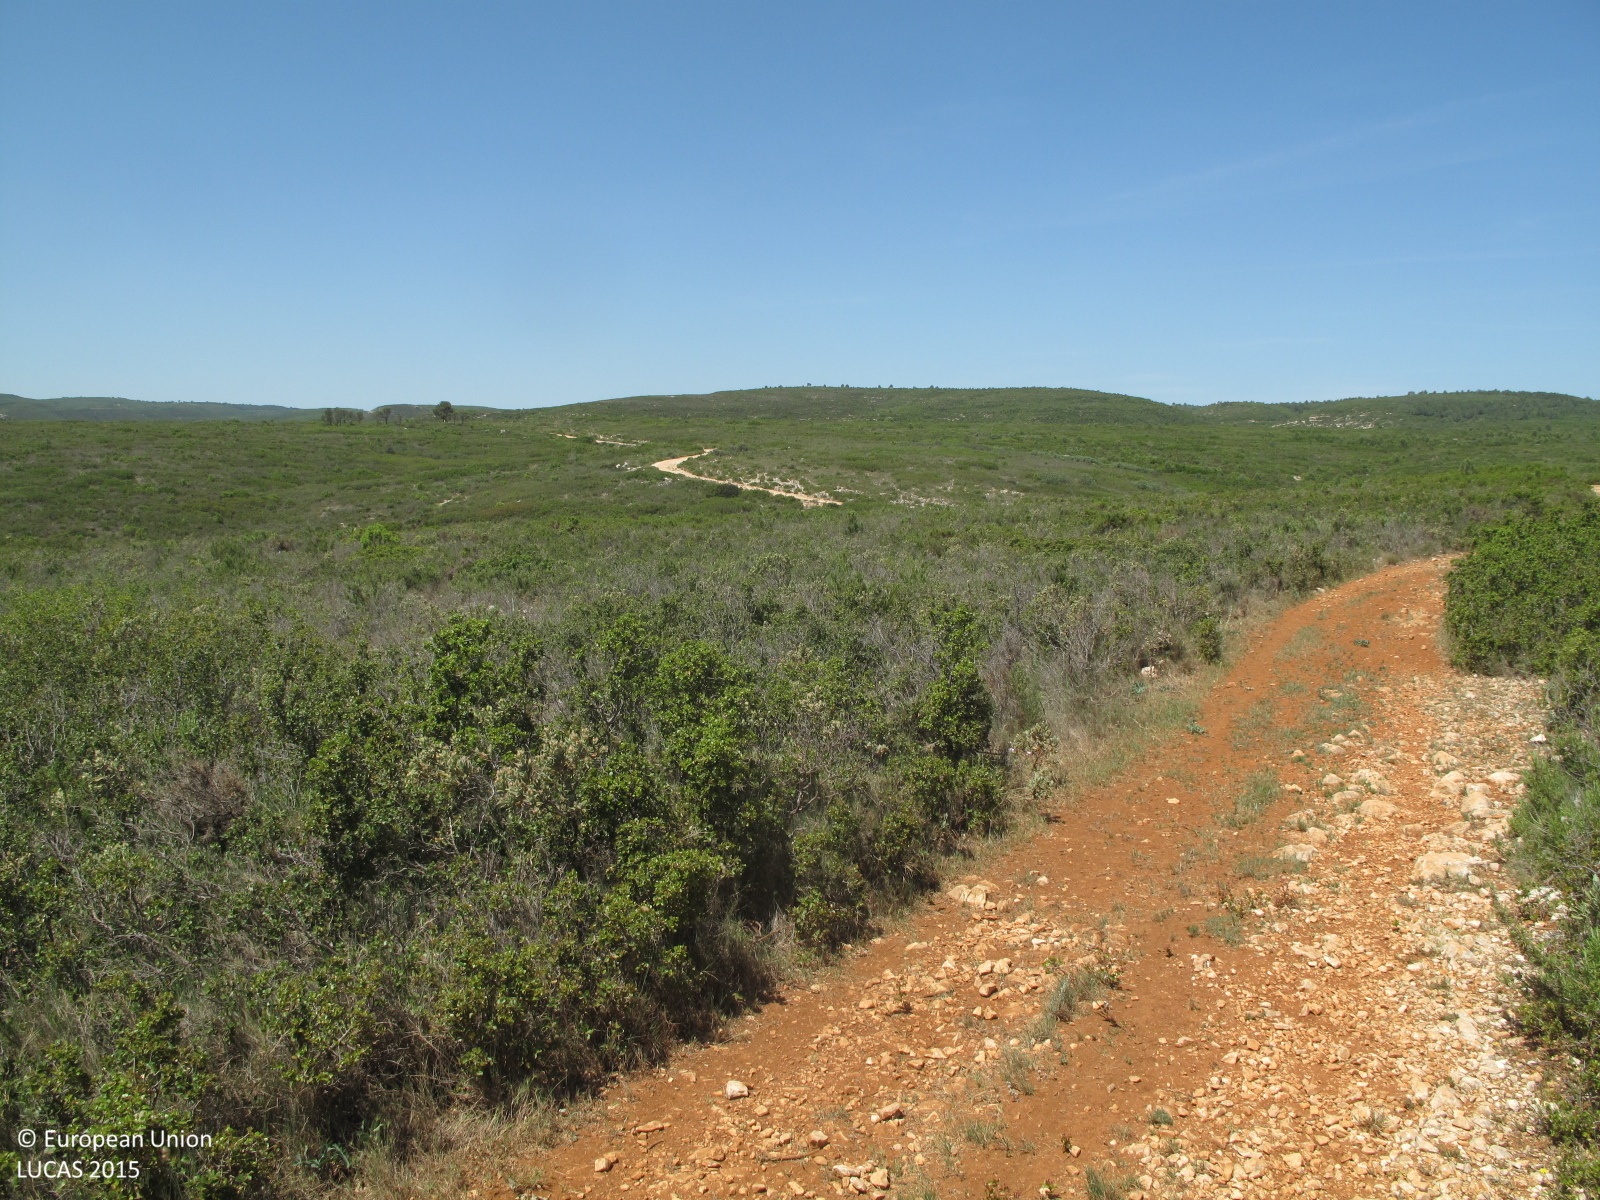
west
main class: Shrubland
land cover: Shrubland without tree cover
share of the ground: 50 - 75 %
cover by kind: shrubs 50 %, consolidated bare surface 30 %, herbaceous plants 20 %
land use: Semi-natural and natural areas not in use
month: May
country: ES
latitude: 38.9416
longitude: -0.7807
